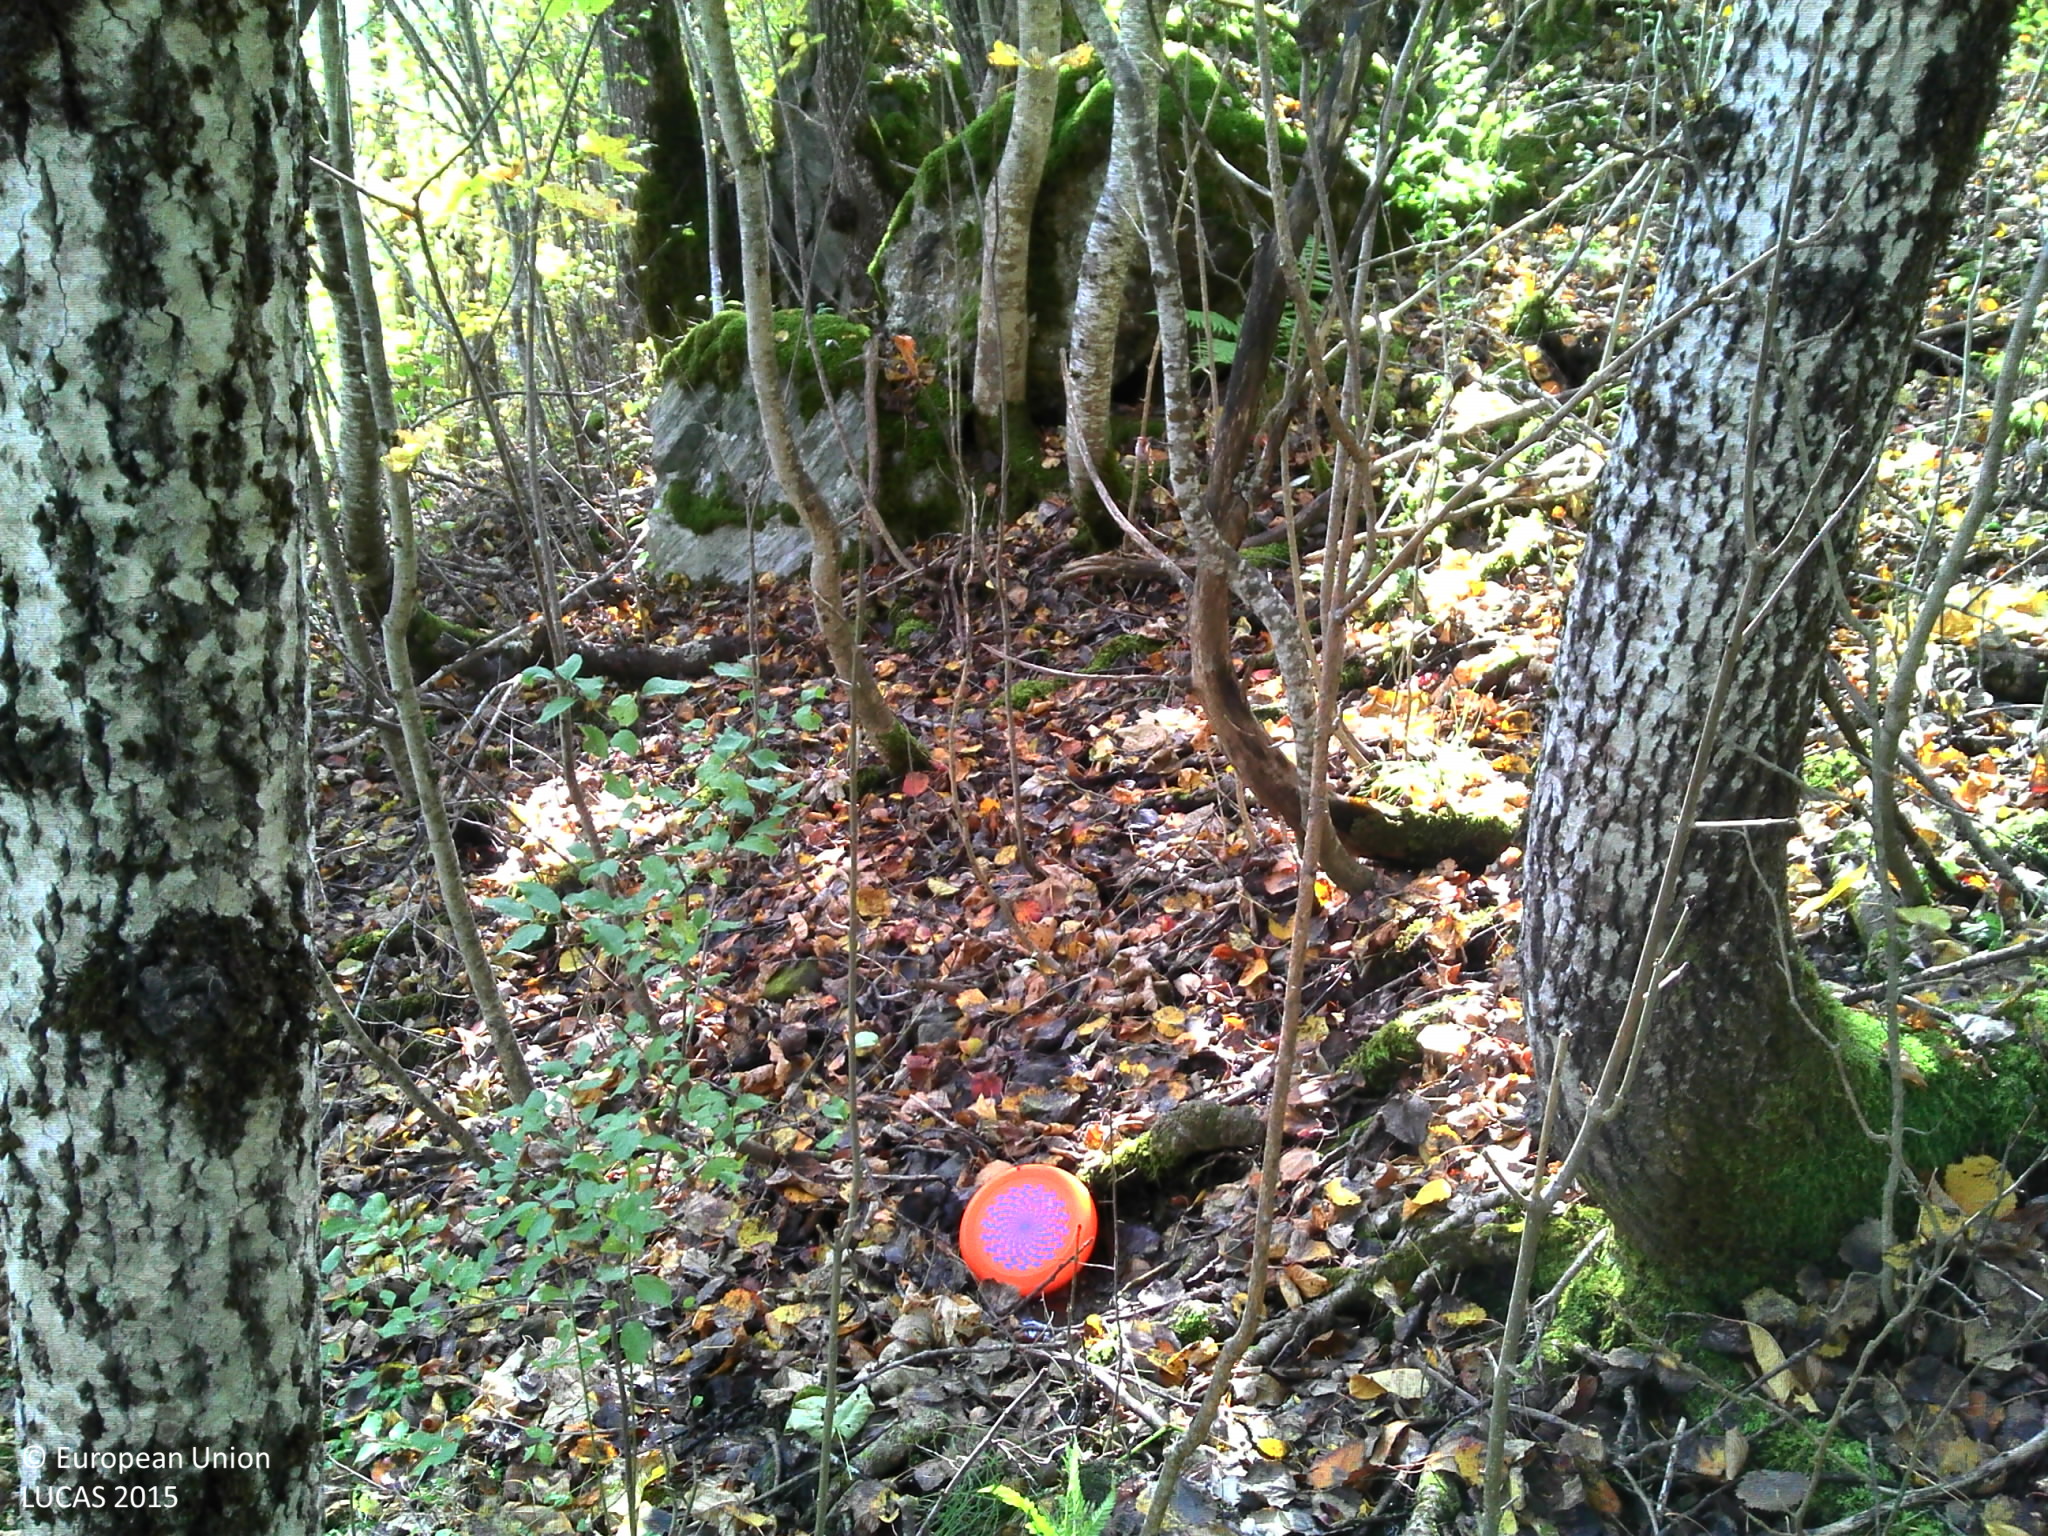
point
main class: Woodland
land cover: Broadleaved woodland
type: mesophytic deciduous forest
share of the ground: > 75 %
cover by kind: broadleaved forest trees 80 %, unconsolidated bare surface 10 %, shrubs 5 %, lichens and mosses 5 %
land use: Forestry
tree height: > 5 m
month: October
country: FR
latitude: 45.2924
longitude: 6.2181
